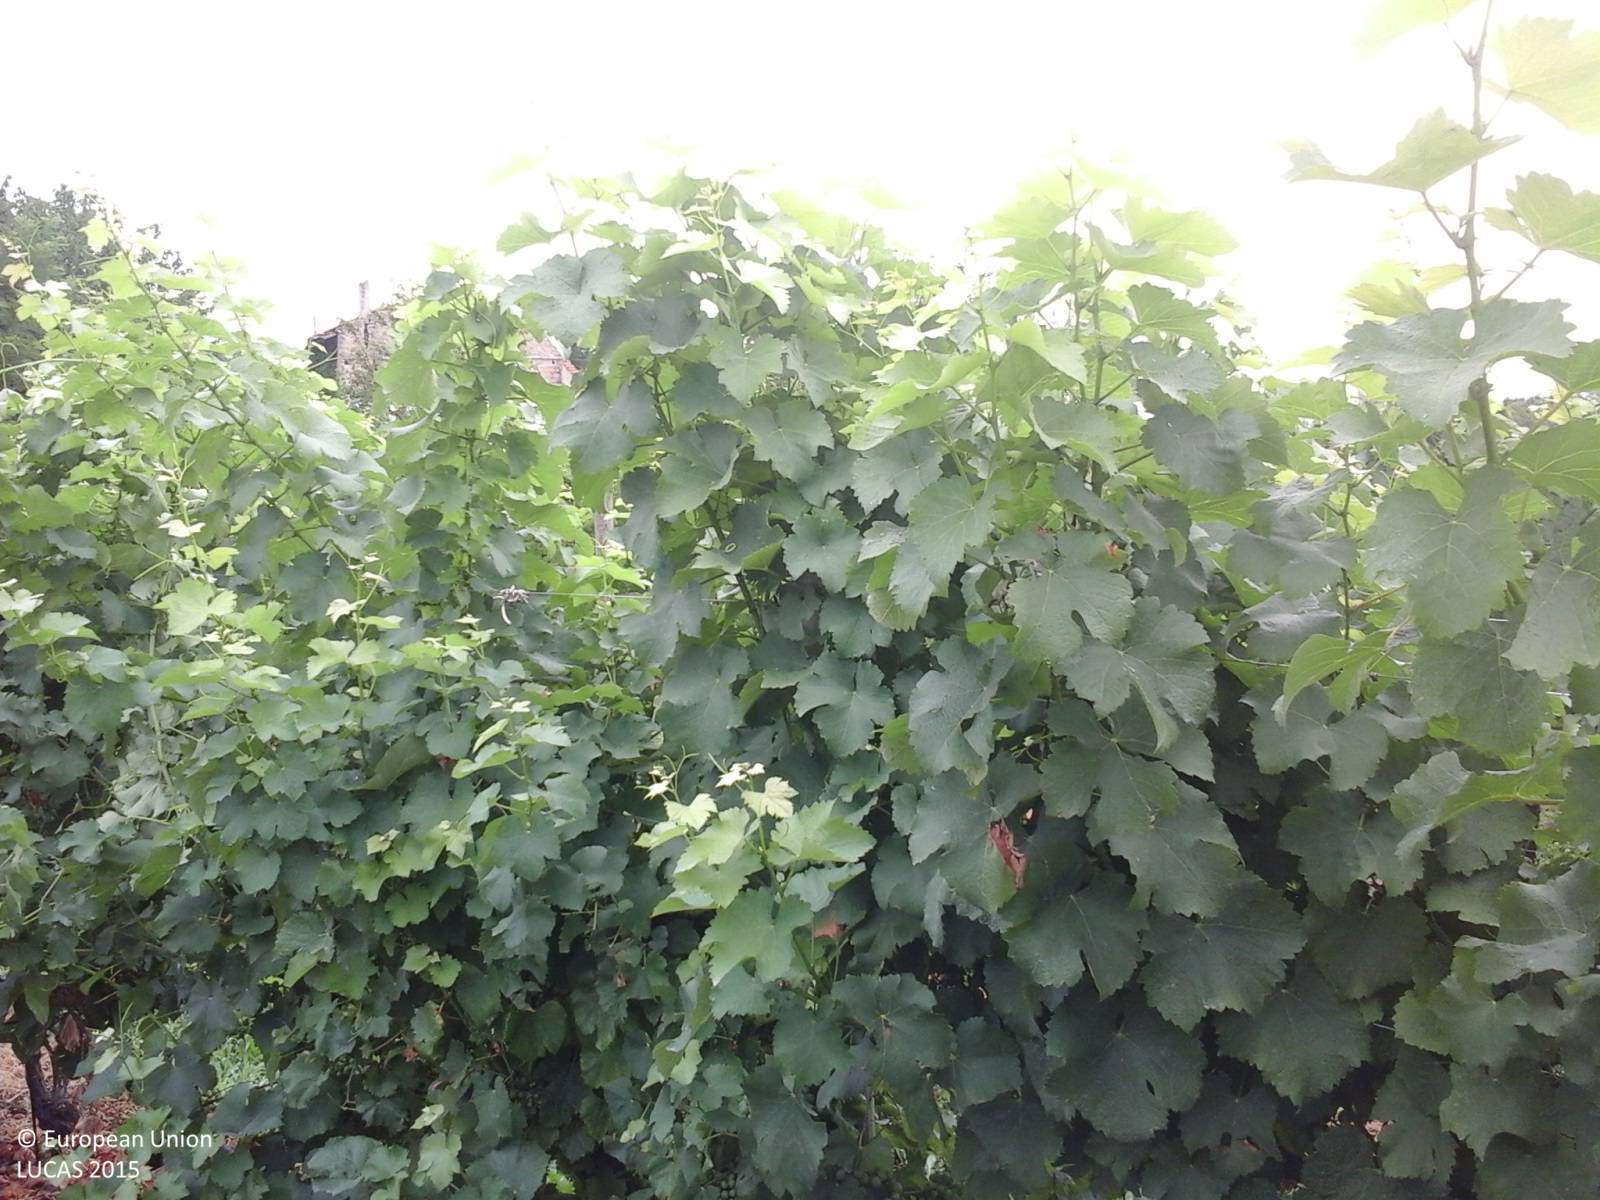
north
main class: Cropland
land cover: Vineyards
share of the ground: 50 - 75 %
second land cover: Grassland without tree/shrub cover
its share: > 75 %
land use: Agriculture (excluding fallow land and kitchen gardens)
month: July
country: IT
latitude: 45.9838
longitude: 13.0299
